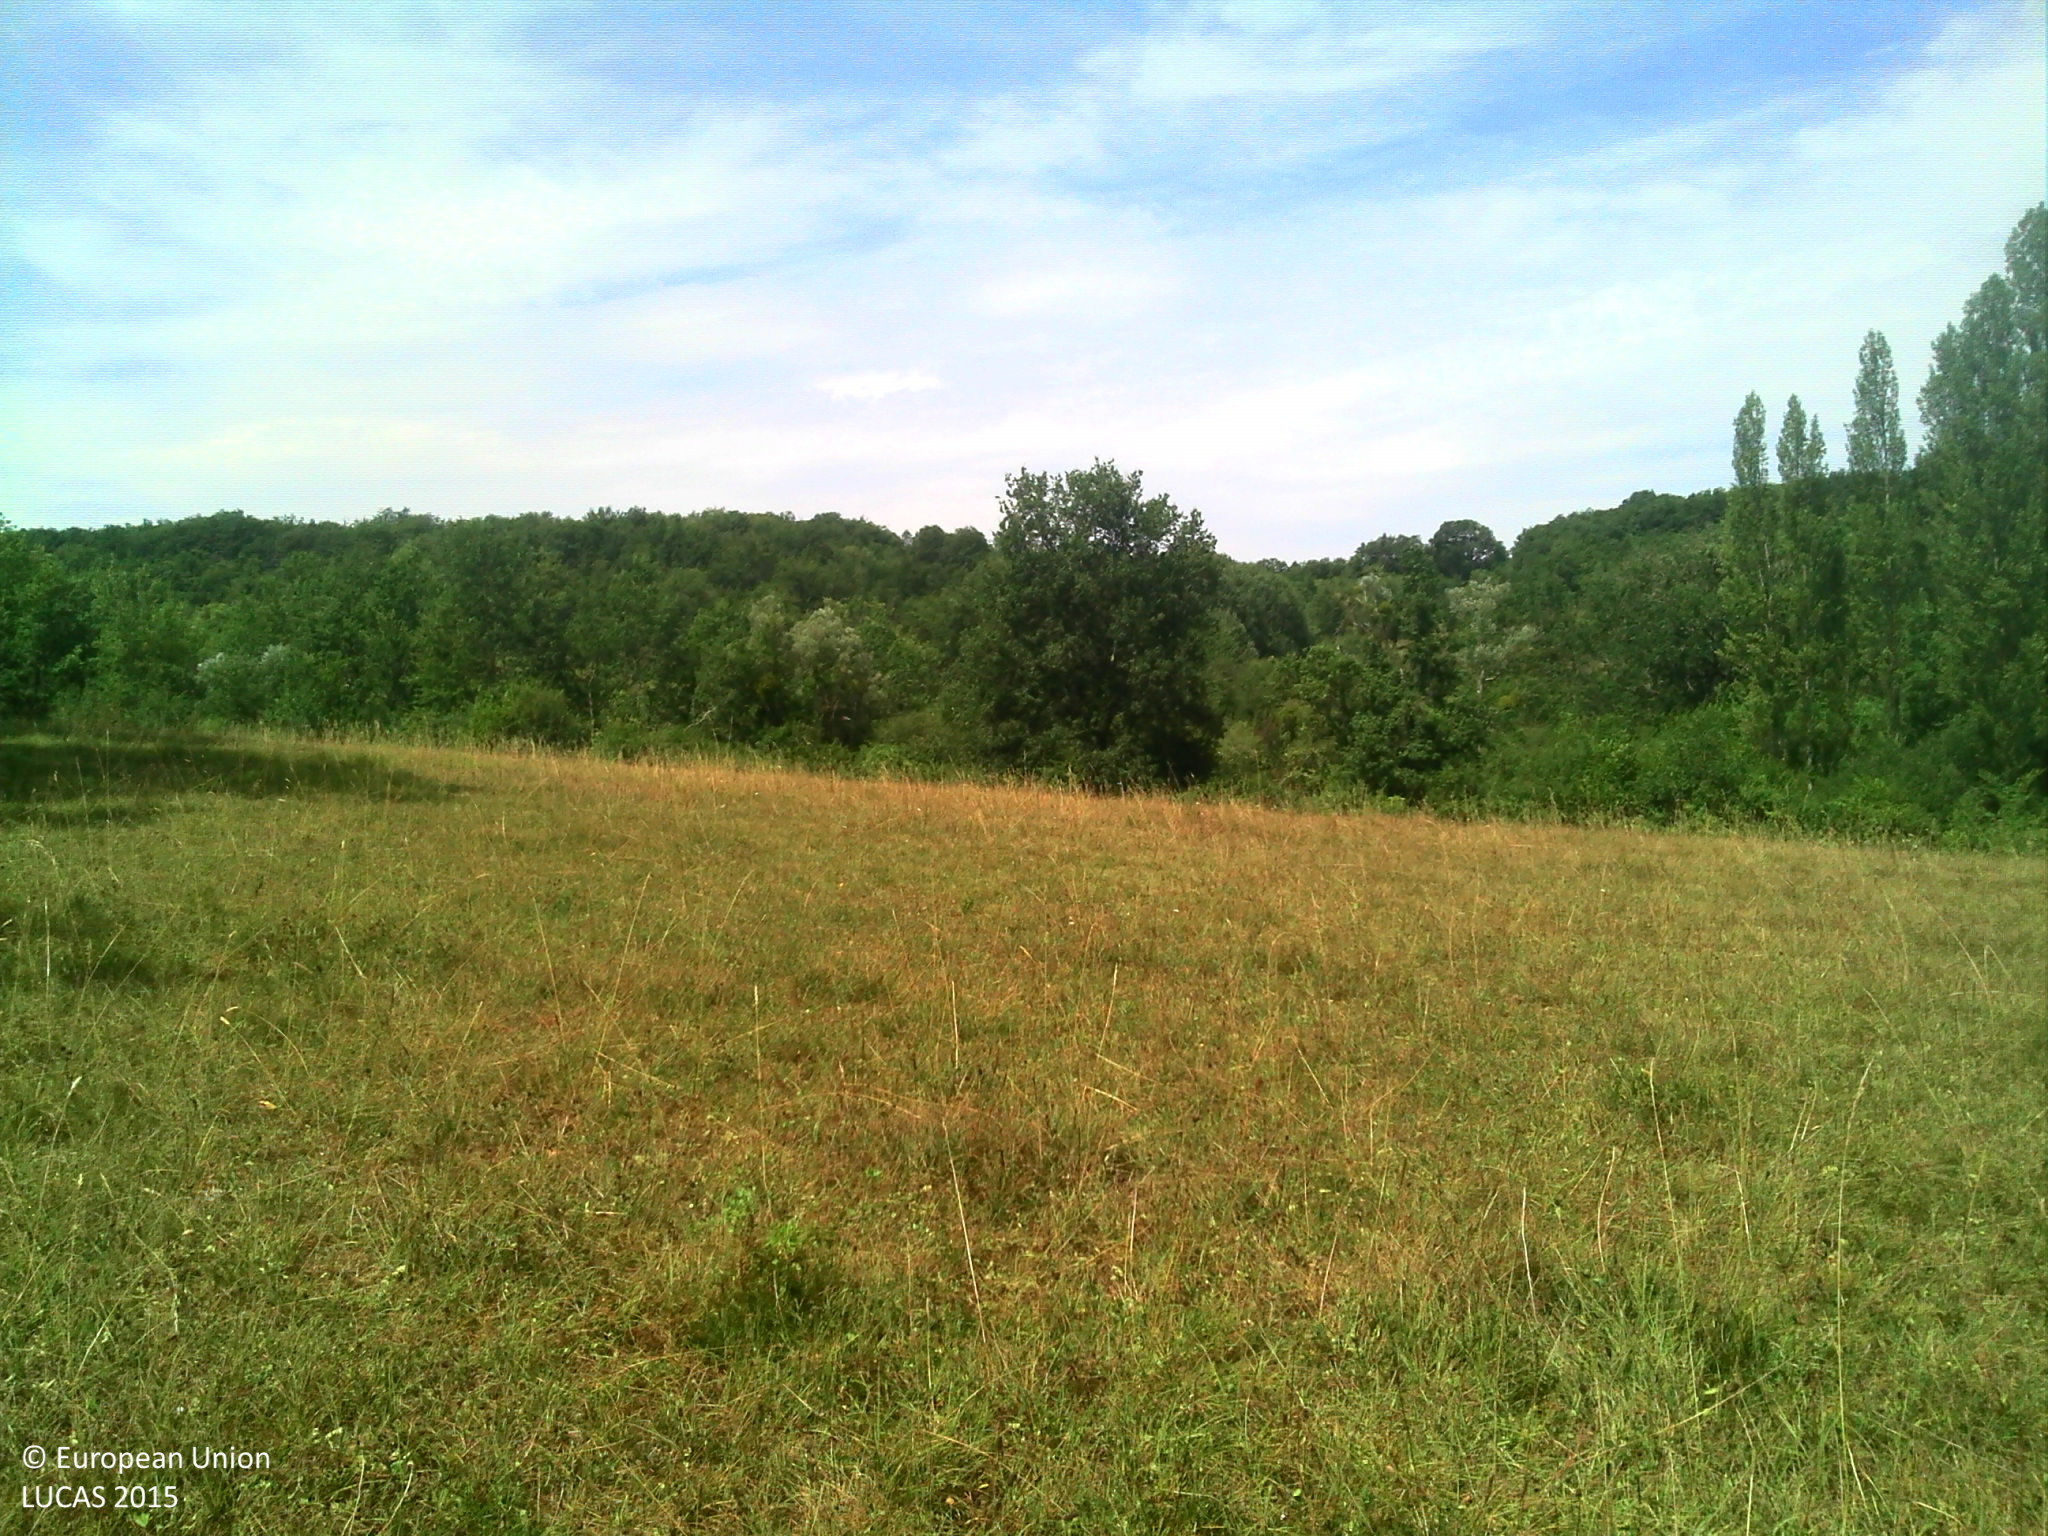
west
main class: Grassland
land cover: Grassland without tree/shrub cover
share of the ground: > 75 %
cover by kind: herbaceous plants 100 %
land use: Agriculture (excluding fallow land and kitchen gardens)
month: July
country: FR
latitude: 43.1664
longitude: 0.8634
